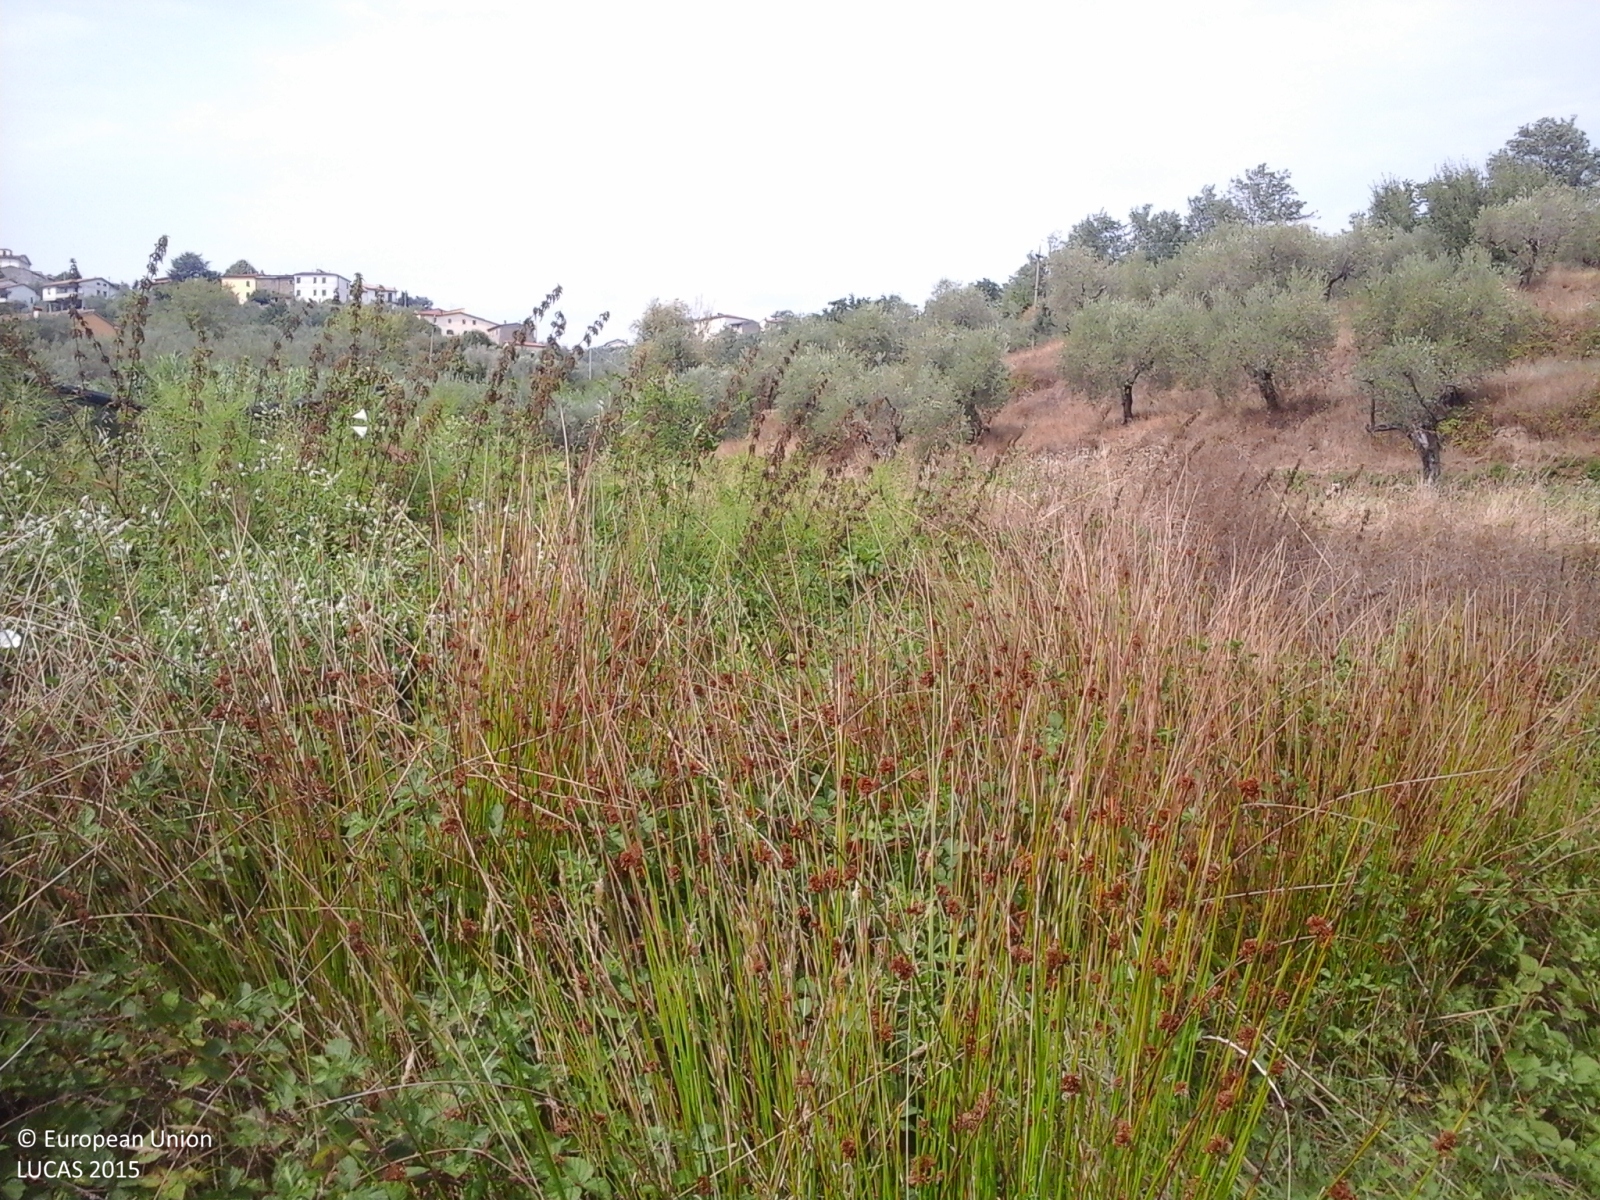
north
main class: Grassland
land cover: Spontaneously vegetated surfaces
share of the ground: > 75 %
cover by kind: herbaceous plants 100 %
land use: Semi-natural and natural areas not in use
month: August
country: IT
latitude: 43.9680
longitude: 10.8827
